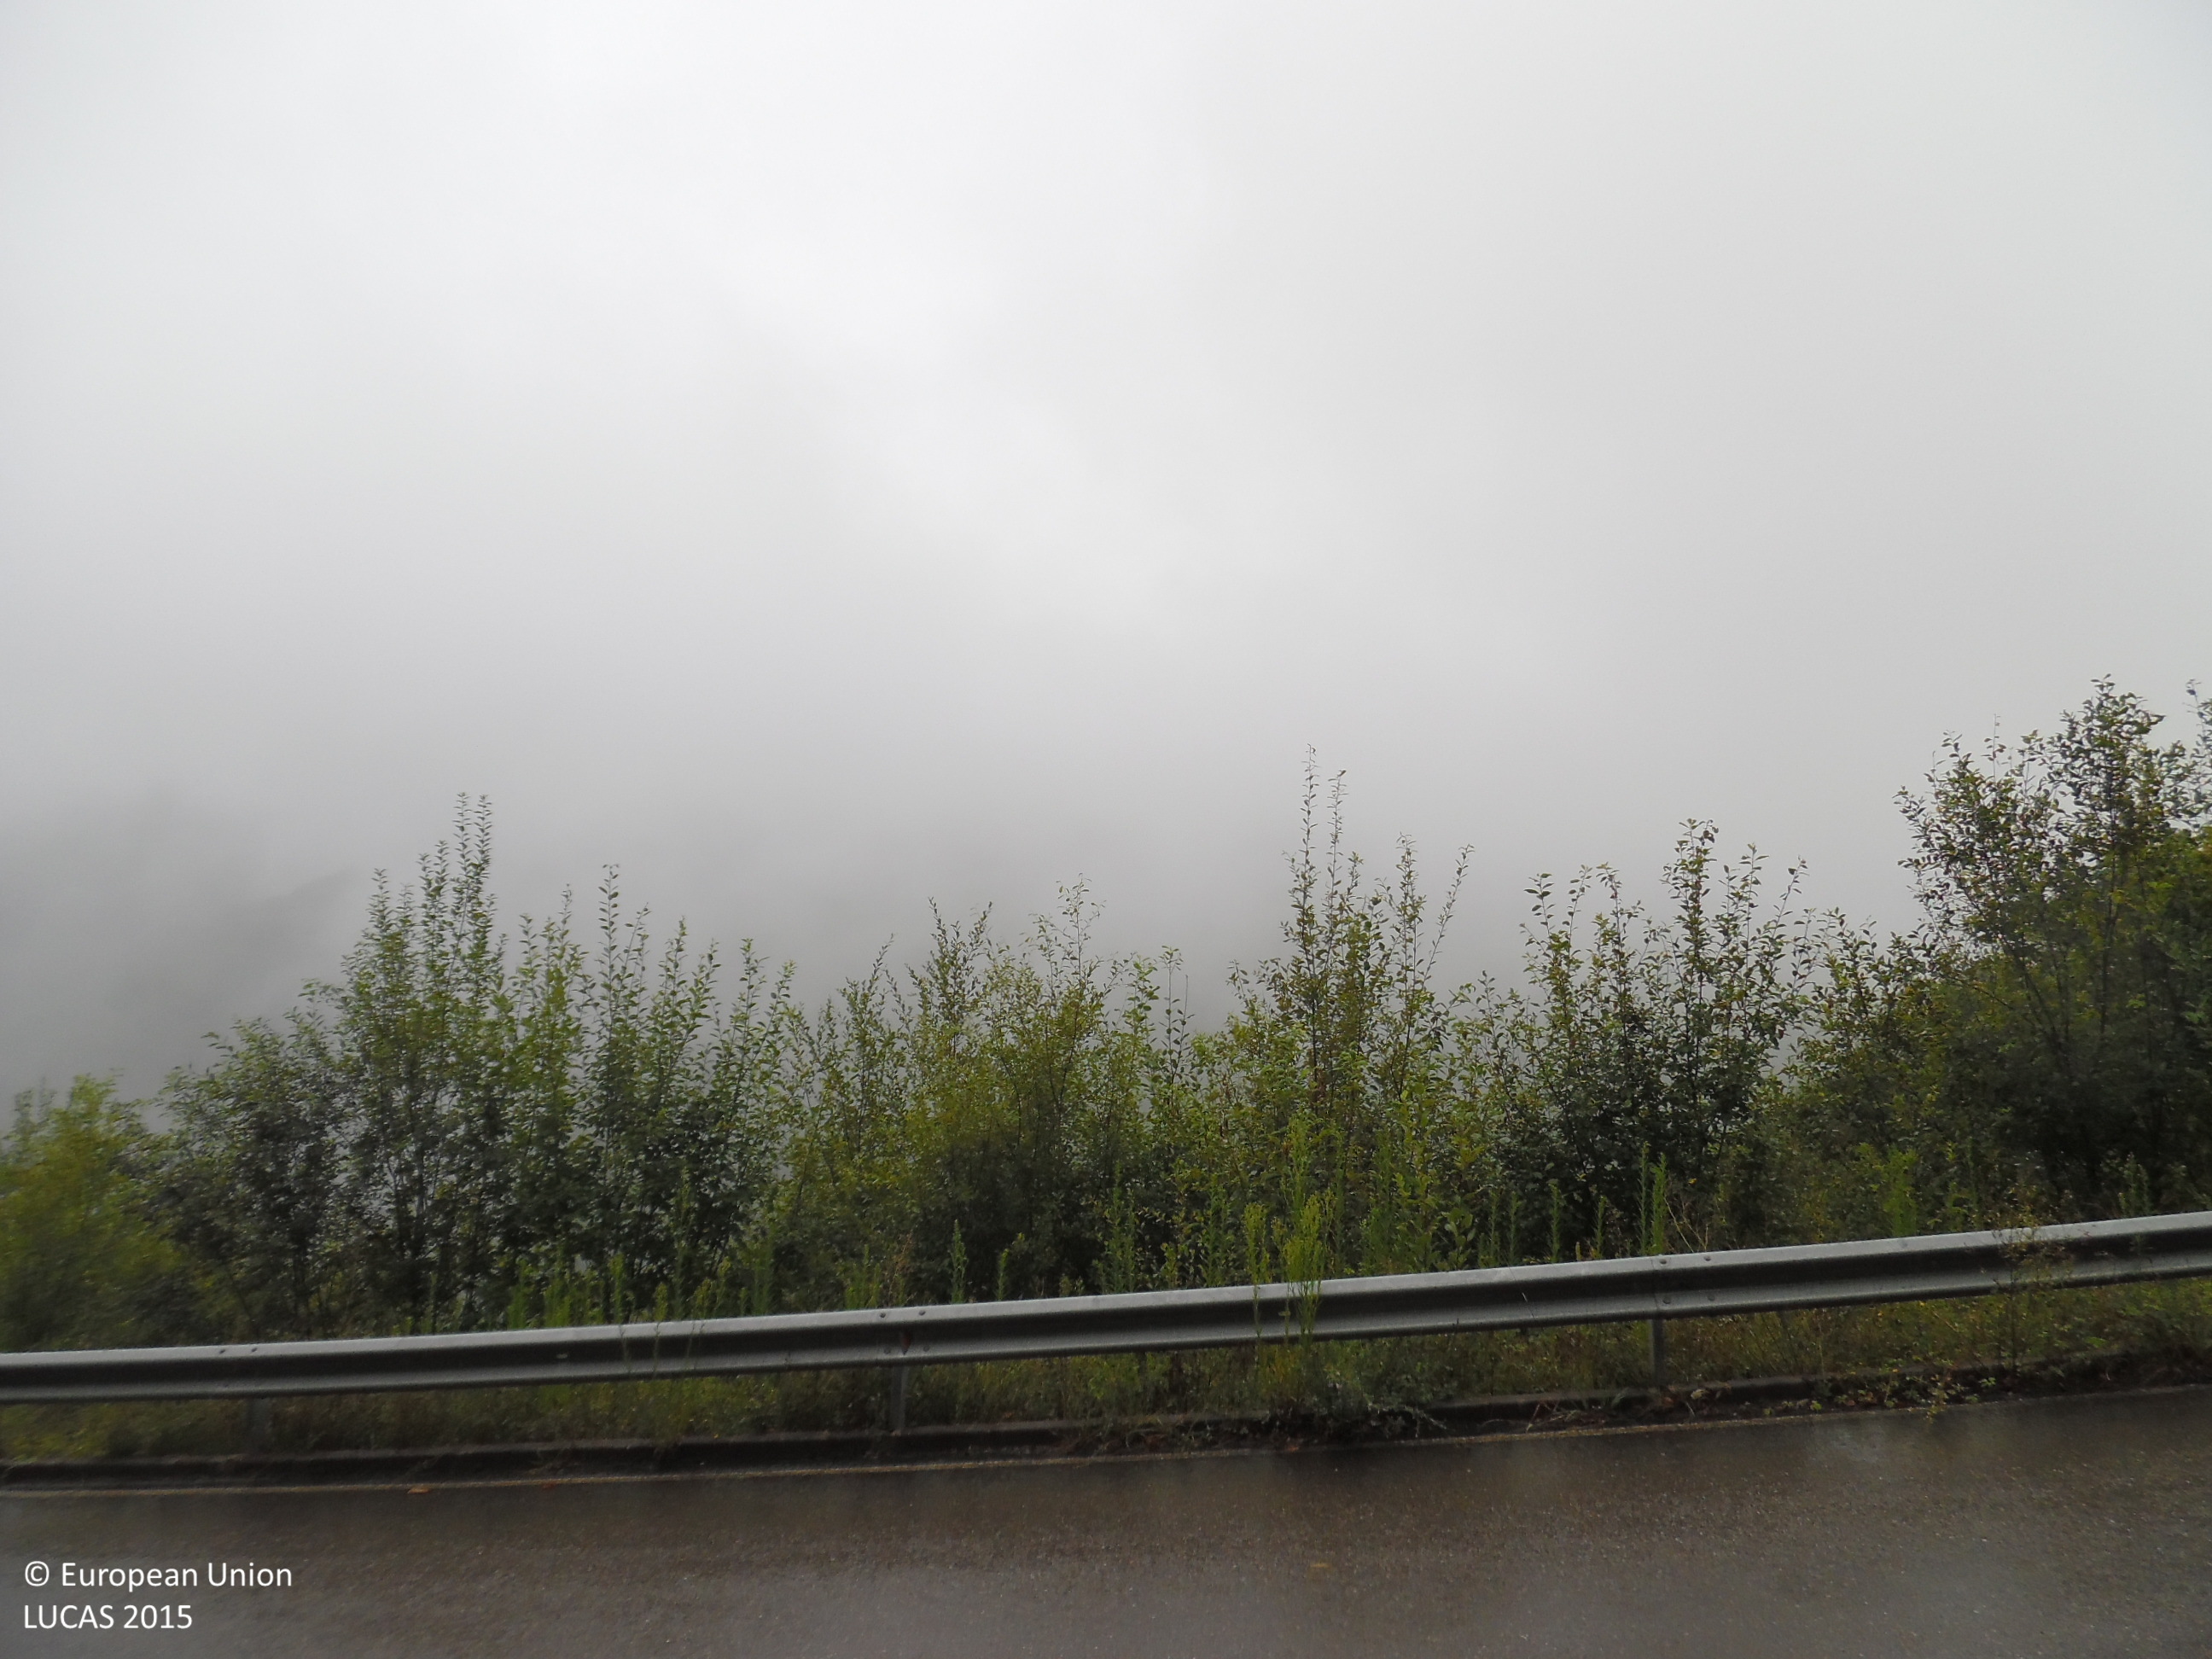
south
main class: Woodland
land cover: Broadleaved woodland
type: thermophilous deciduous forest
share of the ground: > 75 %
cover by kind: broadleaved forest trees 100 %
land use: Forestry
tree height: > 5 m
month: July
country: ES
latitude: 43.1575
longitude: -5.8643
